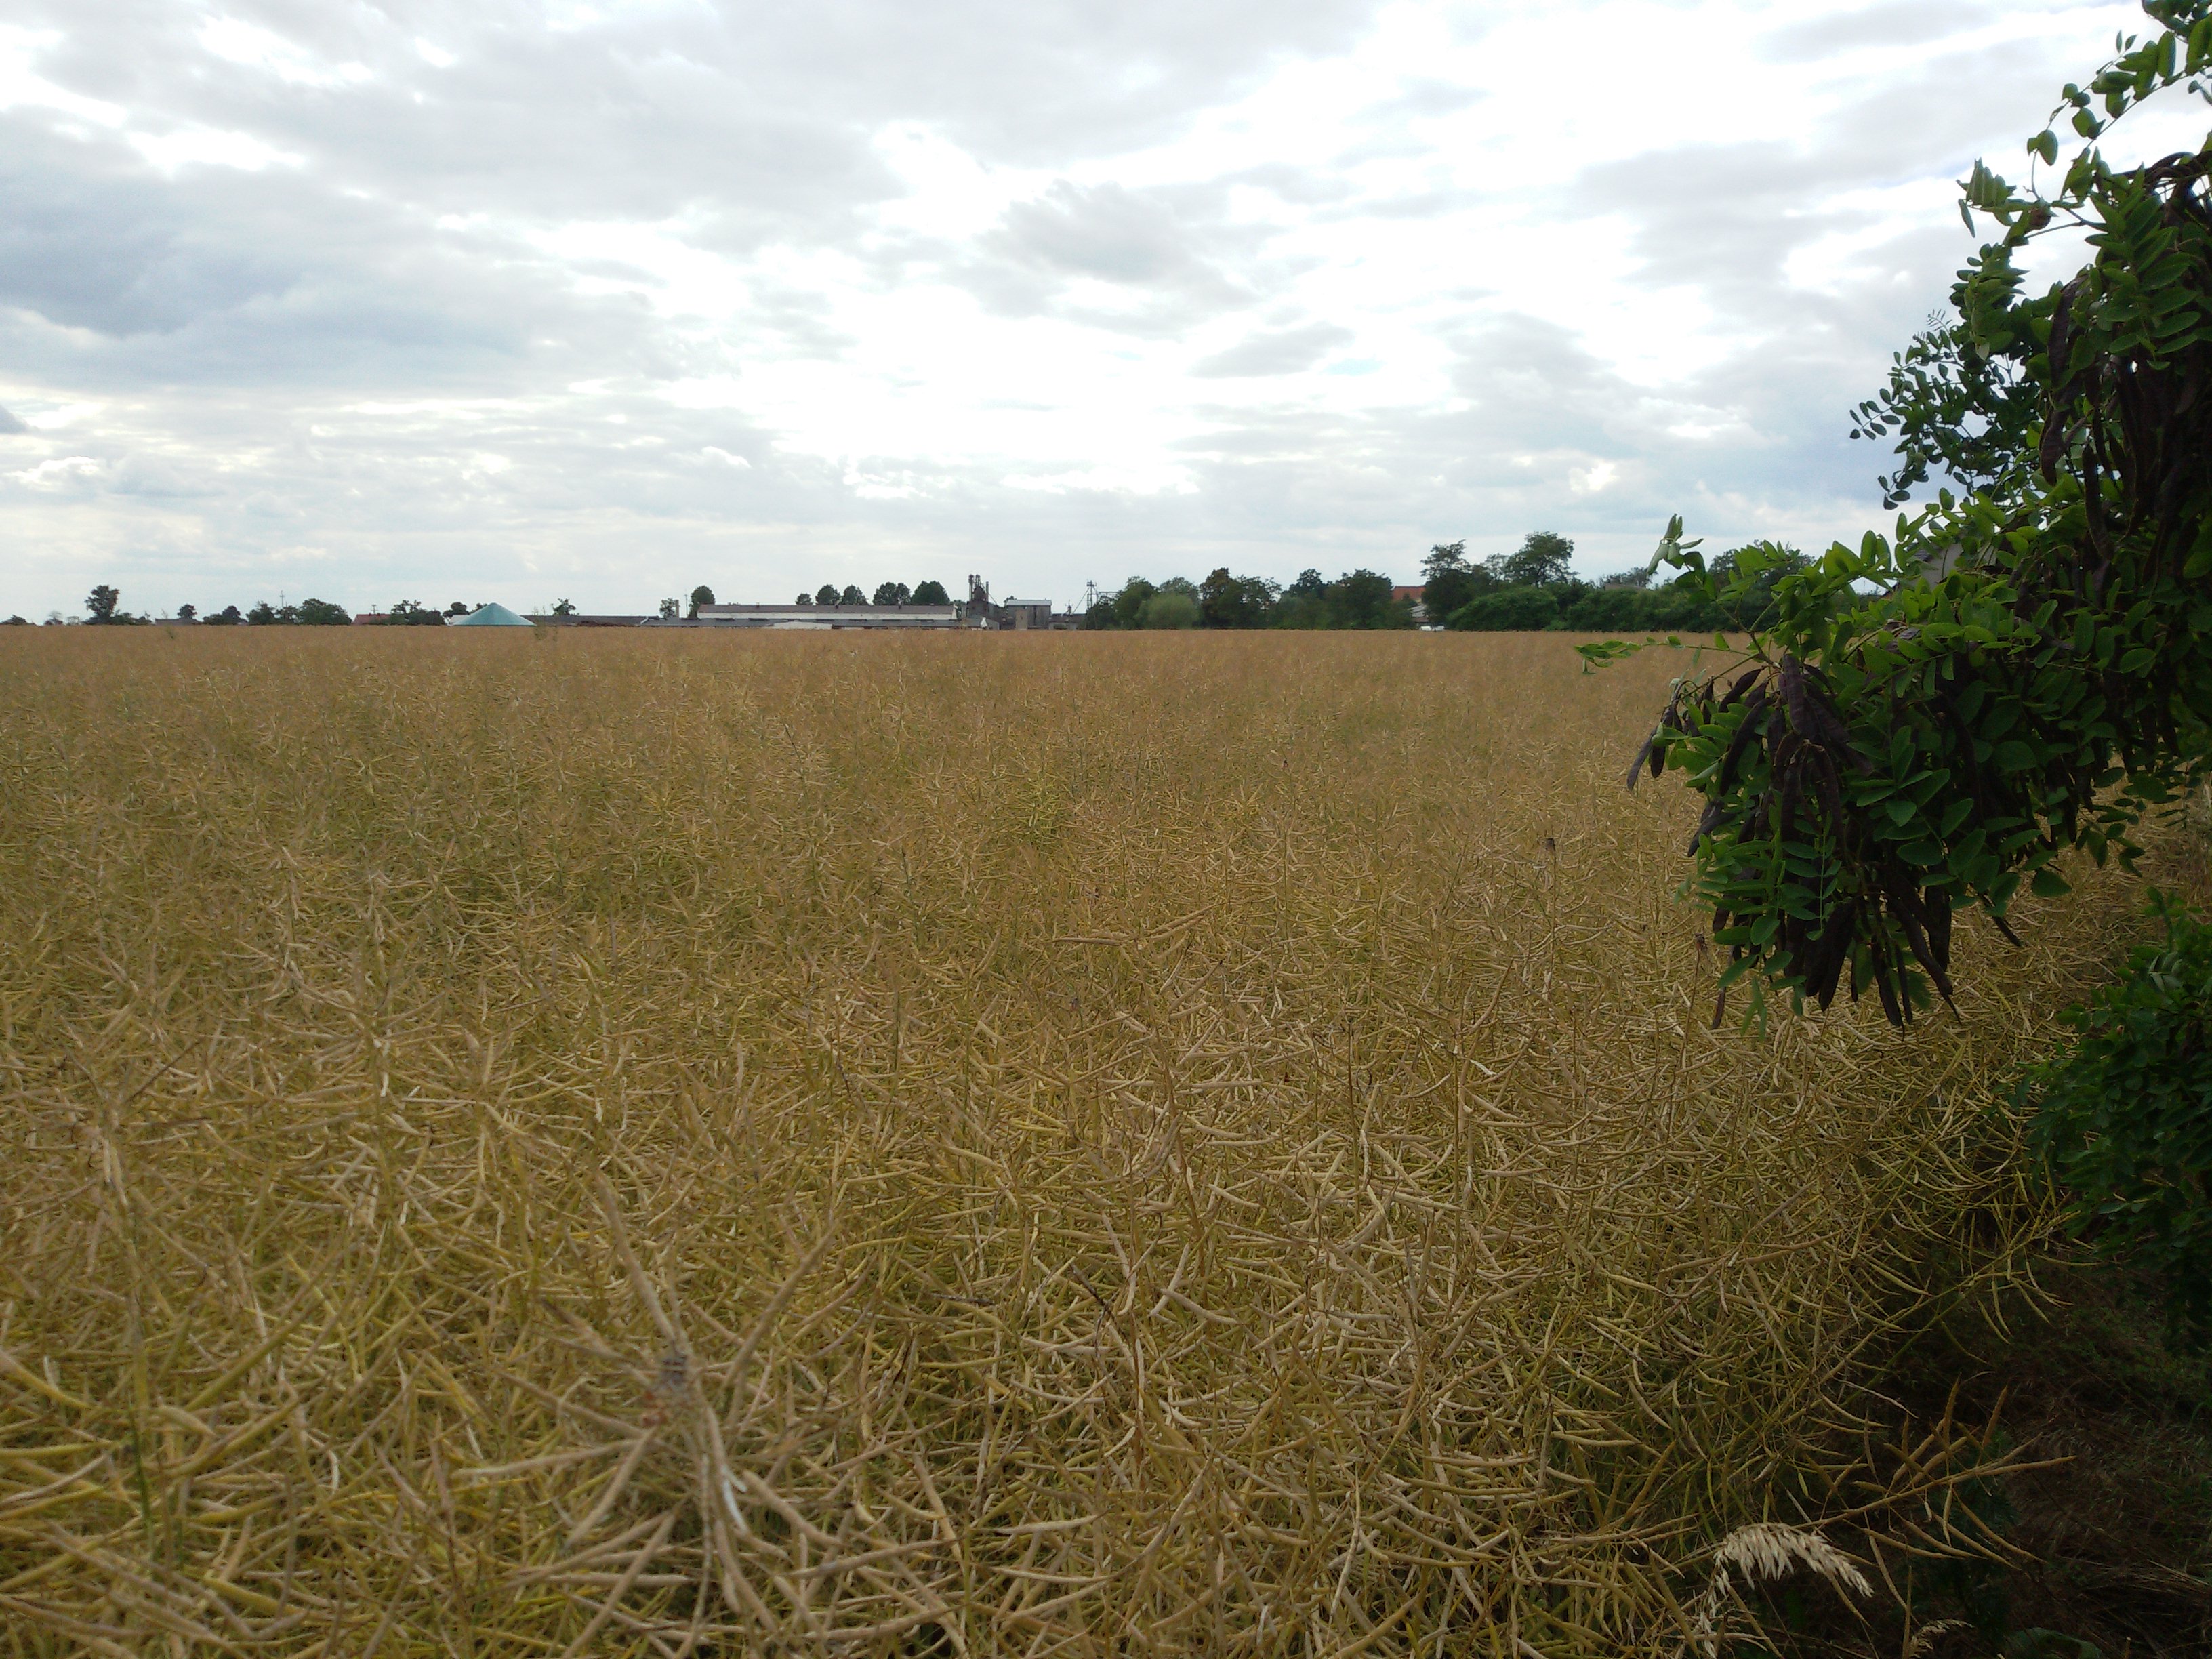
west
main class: Cropland
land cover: Rape and turnip rape
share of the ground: > 75 %
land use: Agriculture (excluding fallow land and kitchen gardens)
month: July
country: PL
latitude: 51.8413
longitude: 17.0789
